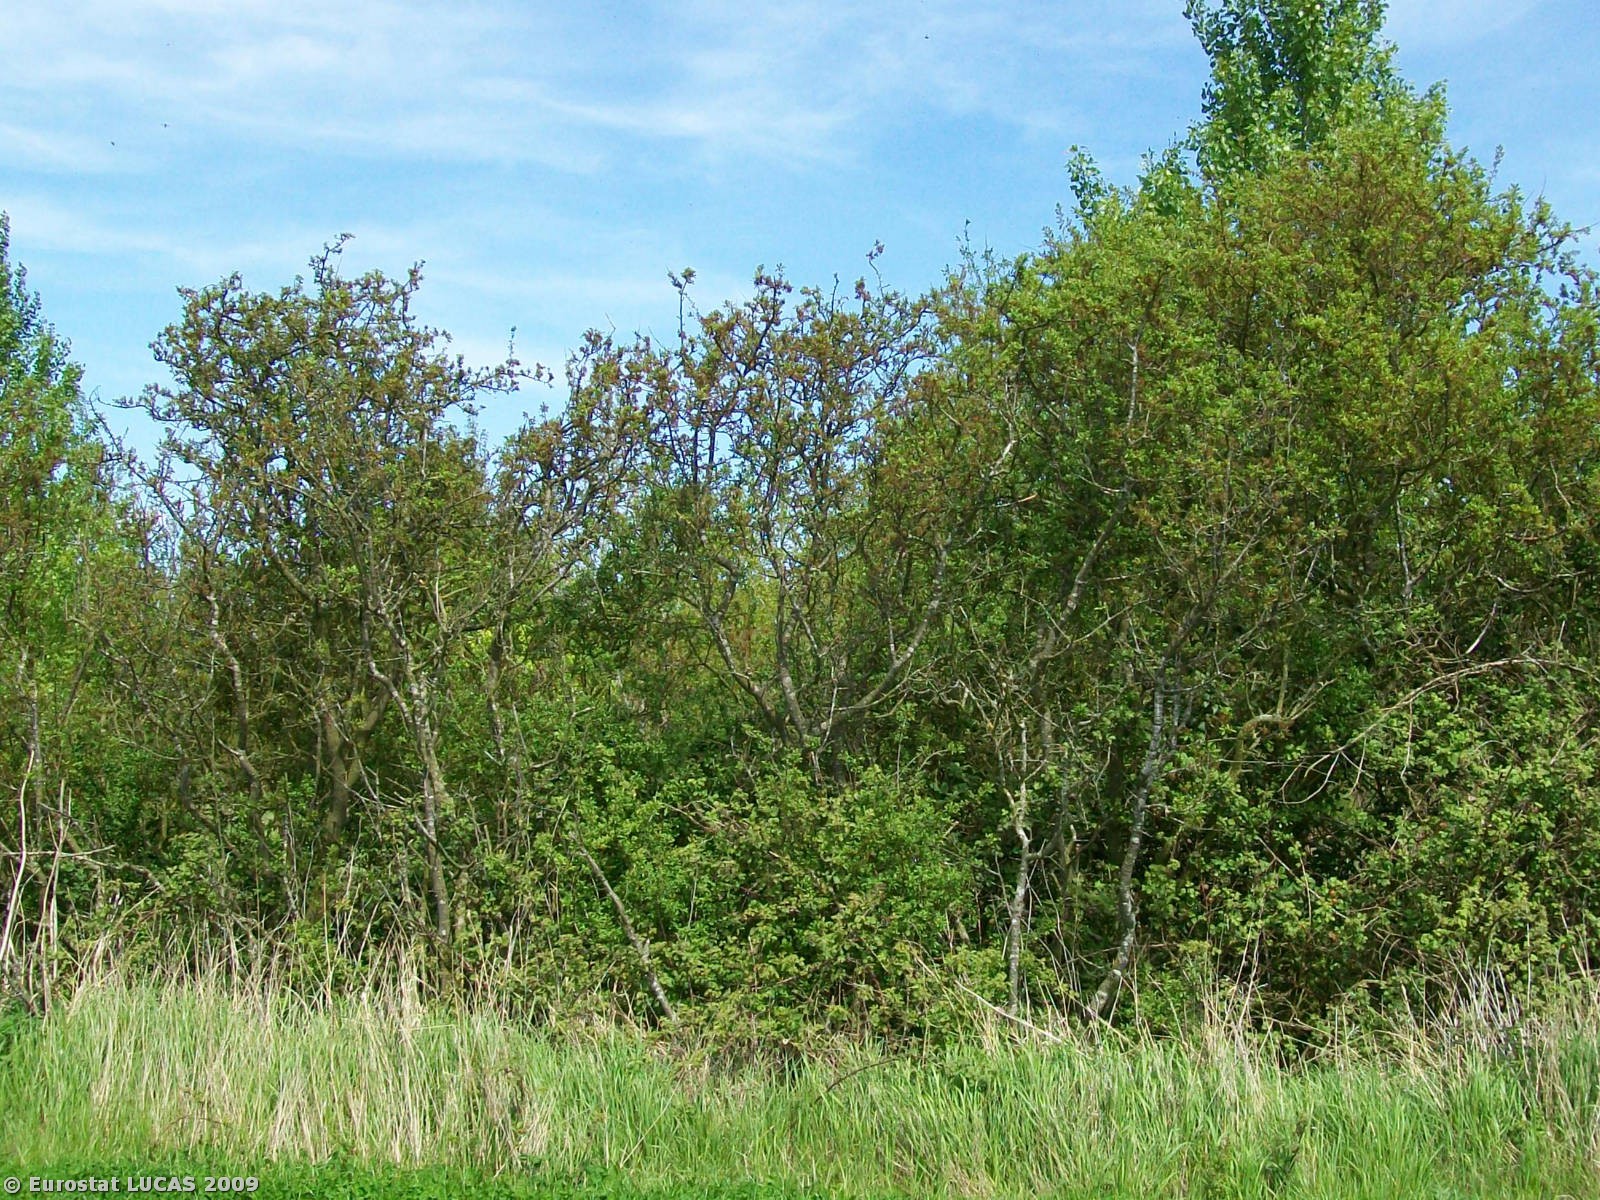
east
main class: Cropland
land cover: Rape and turnip rape
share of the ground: > 75 %
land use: Agriculture (excluding fallow land and kitchen gardens)
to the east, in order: Rape and turnip rape; Grass margins; Abandoned hedges; Rivers and streams; Grassland with sparse tree/shrub cover; Broadleaved woodland; Abandoned hedges; Rivers and streams; Grassland without tree/shrub cover
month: May
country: GB
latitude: 51.8595
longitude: -0.8603
